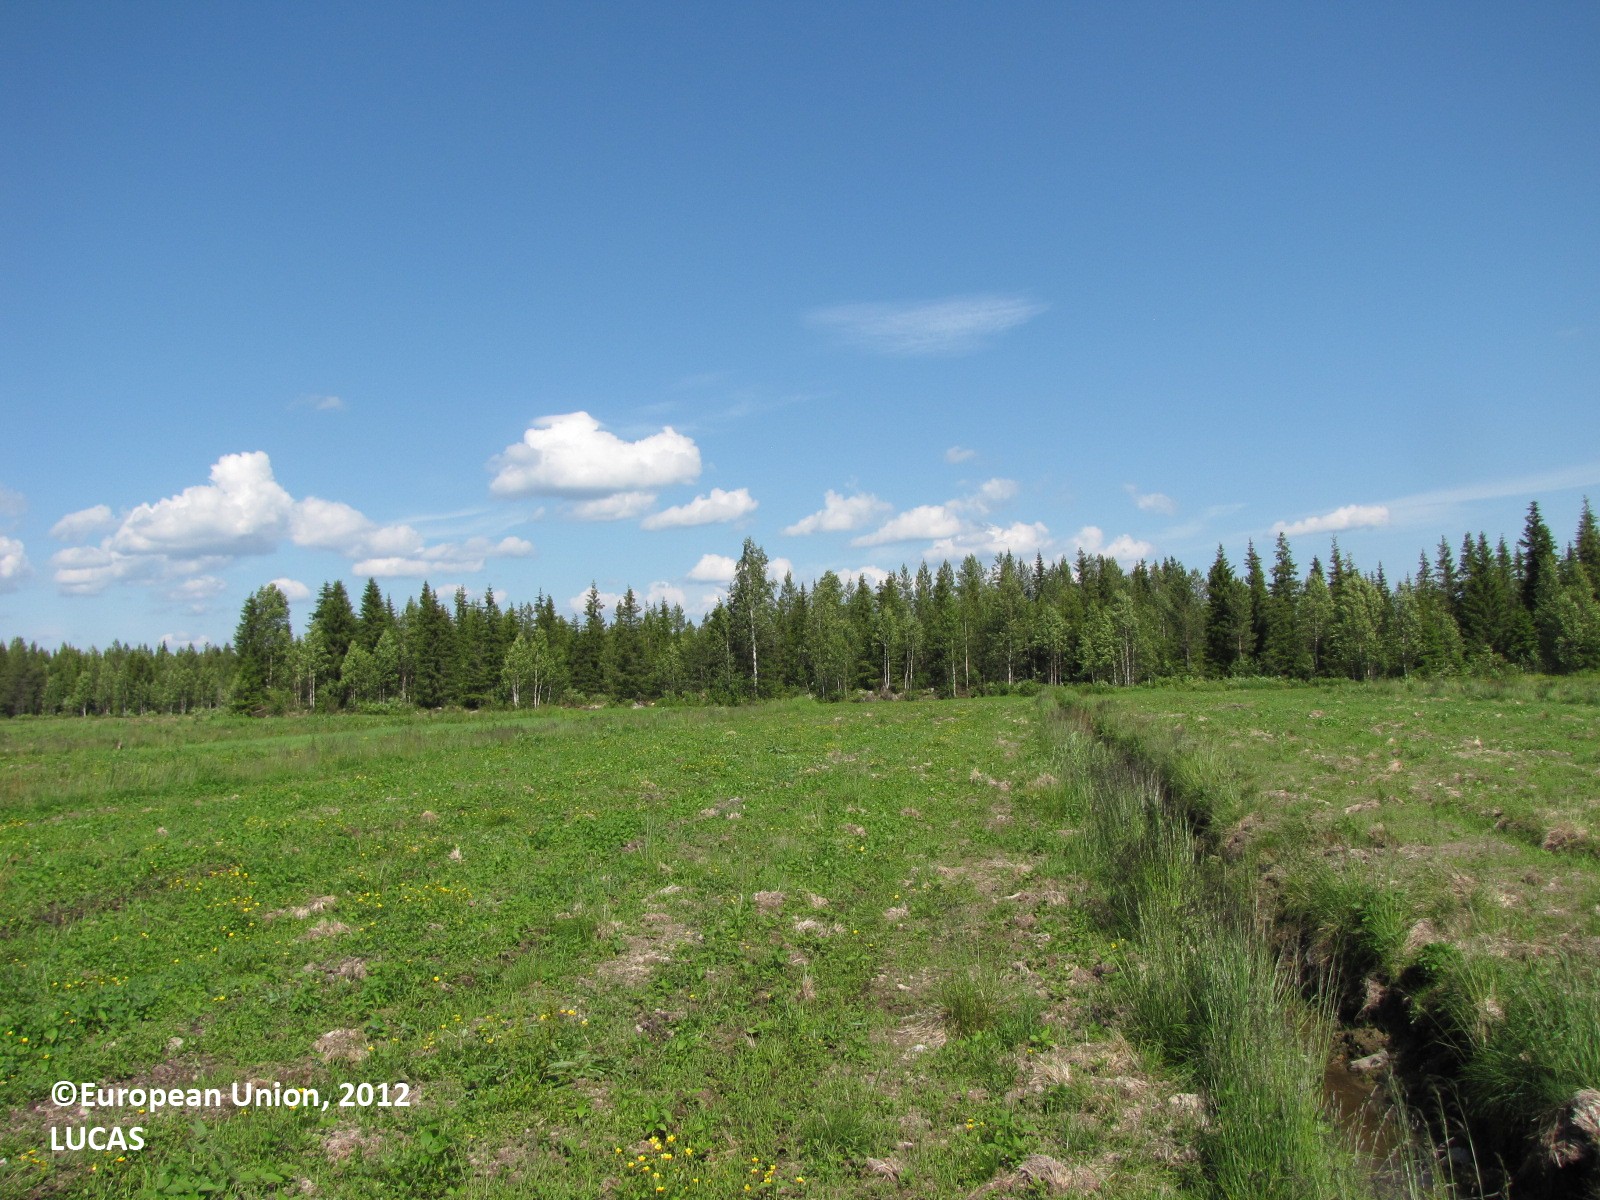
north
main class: Grassland
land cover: Grassland without tree/shrub cover
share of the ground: > 75 %
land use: Agriculture (excluding fallow land and kitchen gardens)
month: July
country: FI
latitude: 66.2650
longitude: 25.2235
